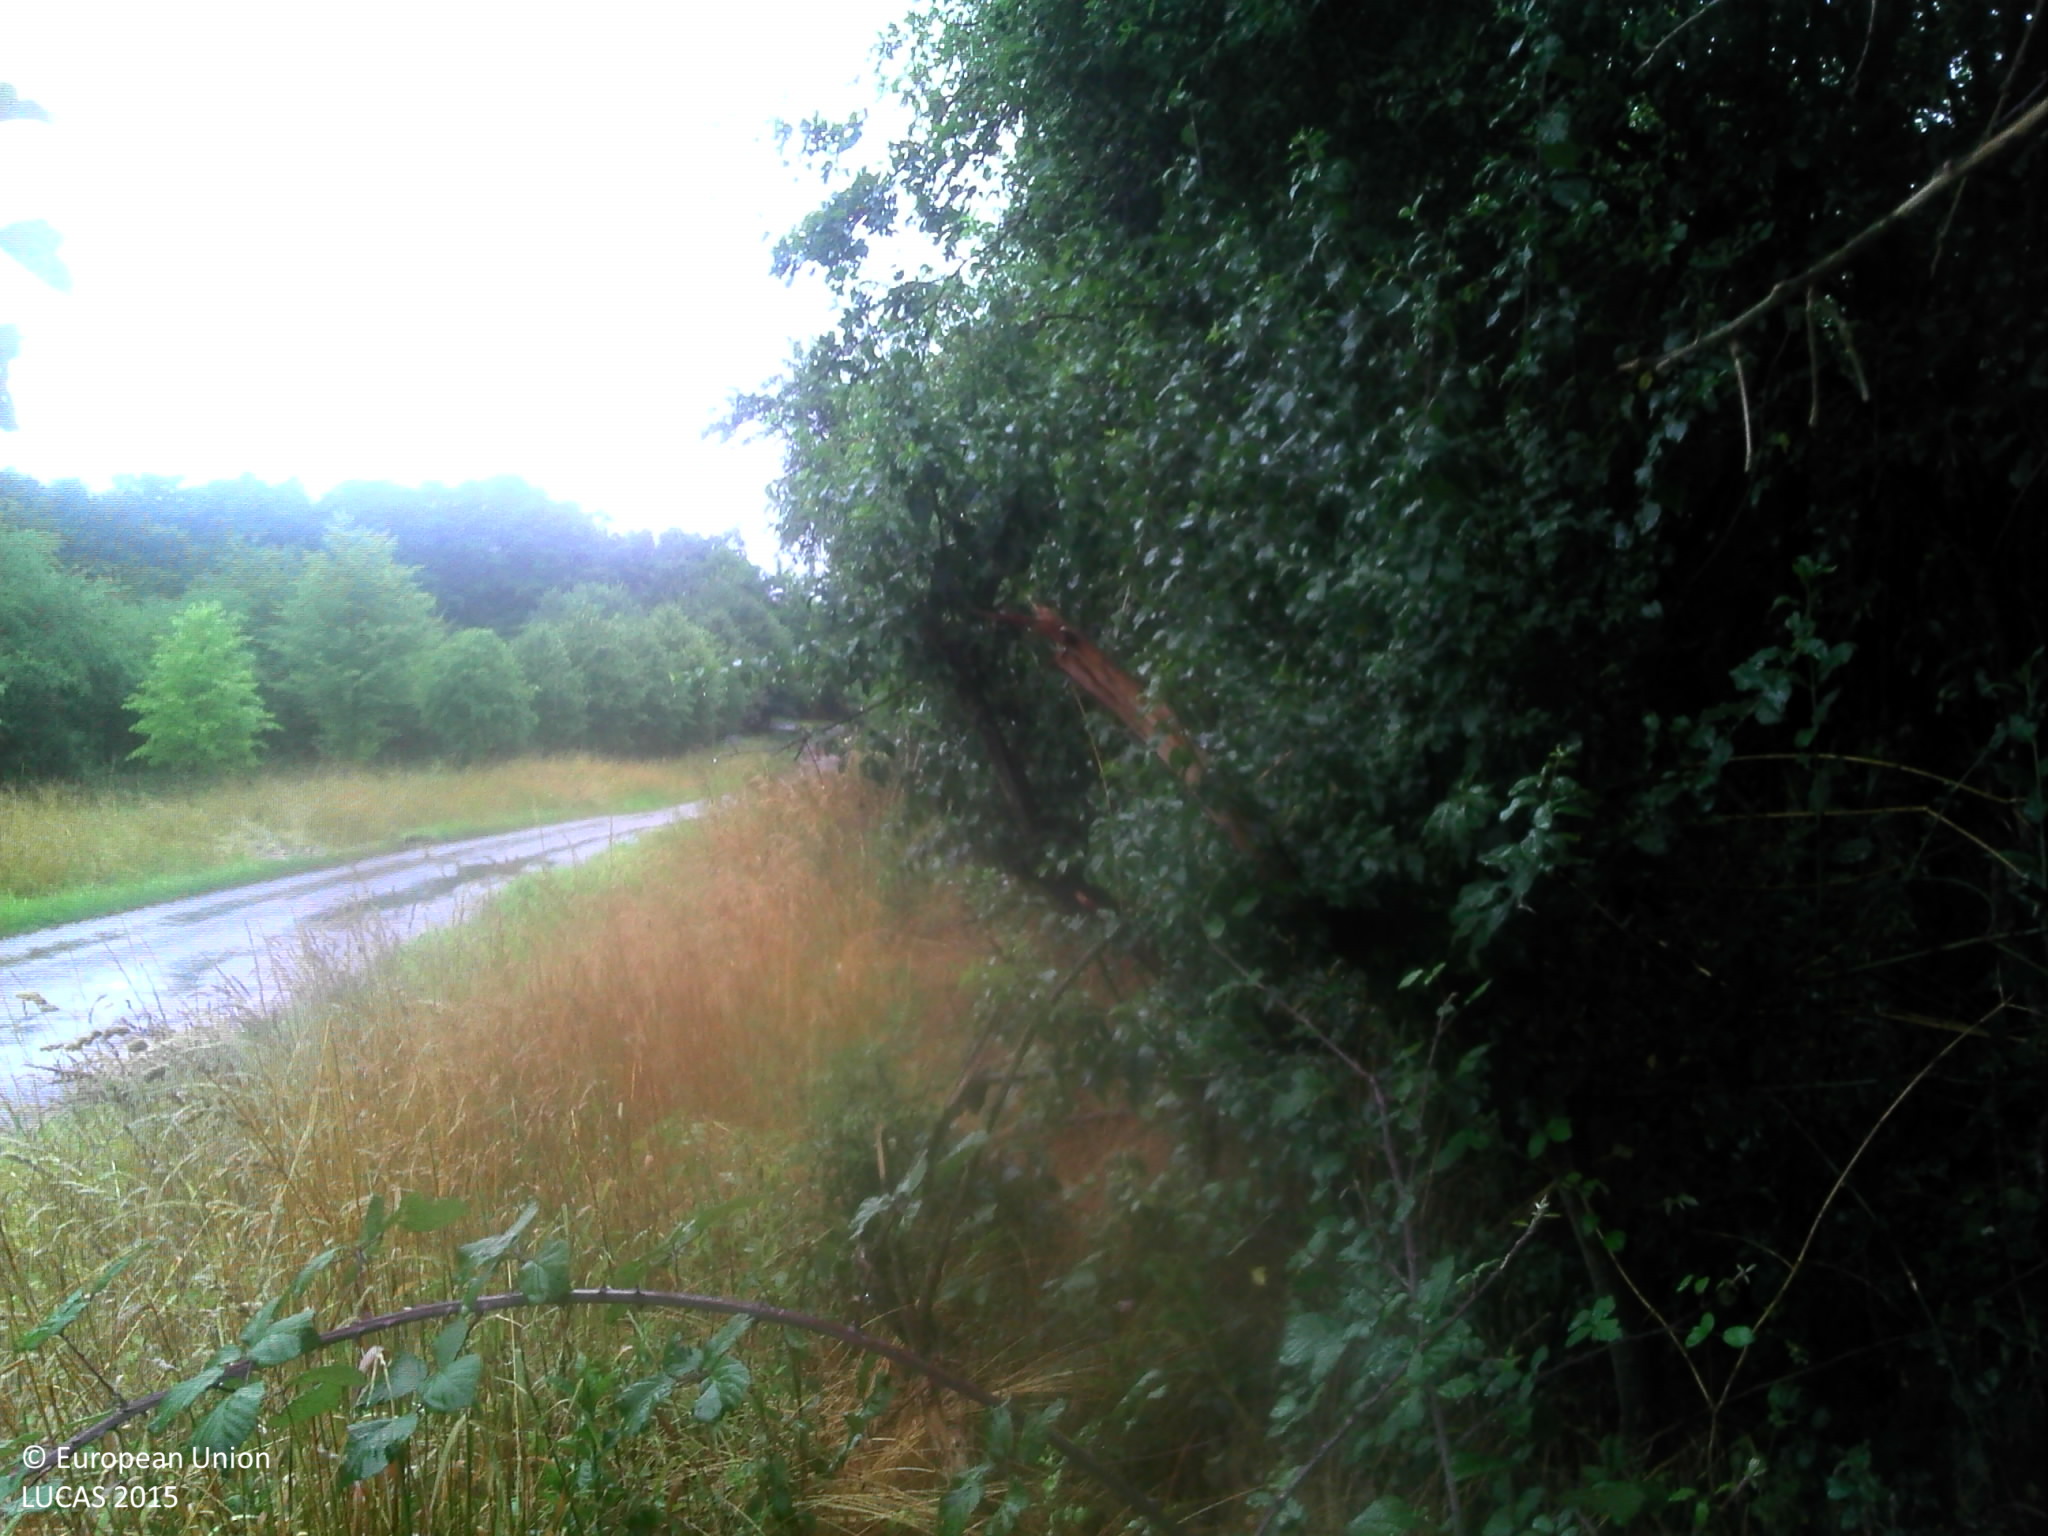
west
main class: Woodland
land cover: Broadleaved woodland
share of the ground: > 75 %
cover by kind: broadleaved forest trees 100 %
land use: Semi-natural and natural areas not in use
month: July
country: BE
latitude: 50.1687
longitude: 4.6903
